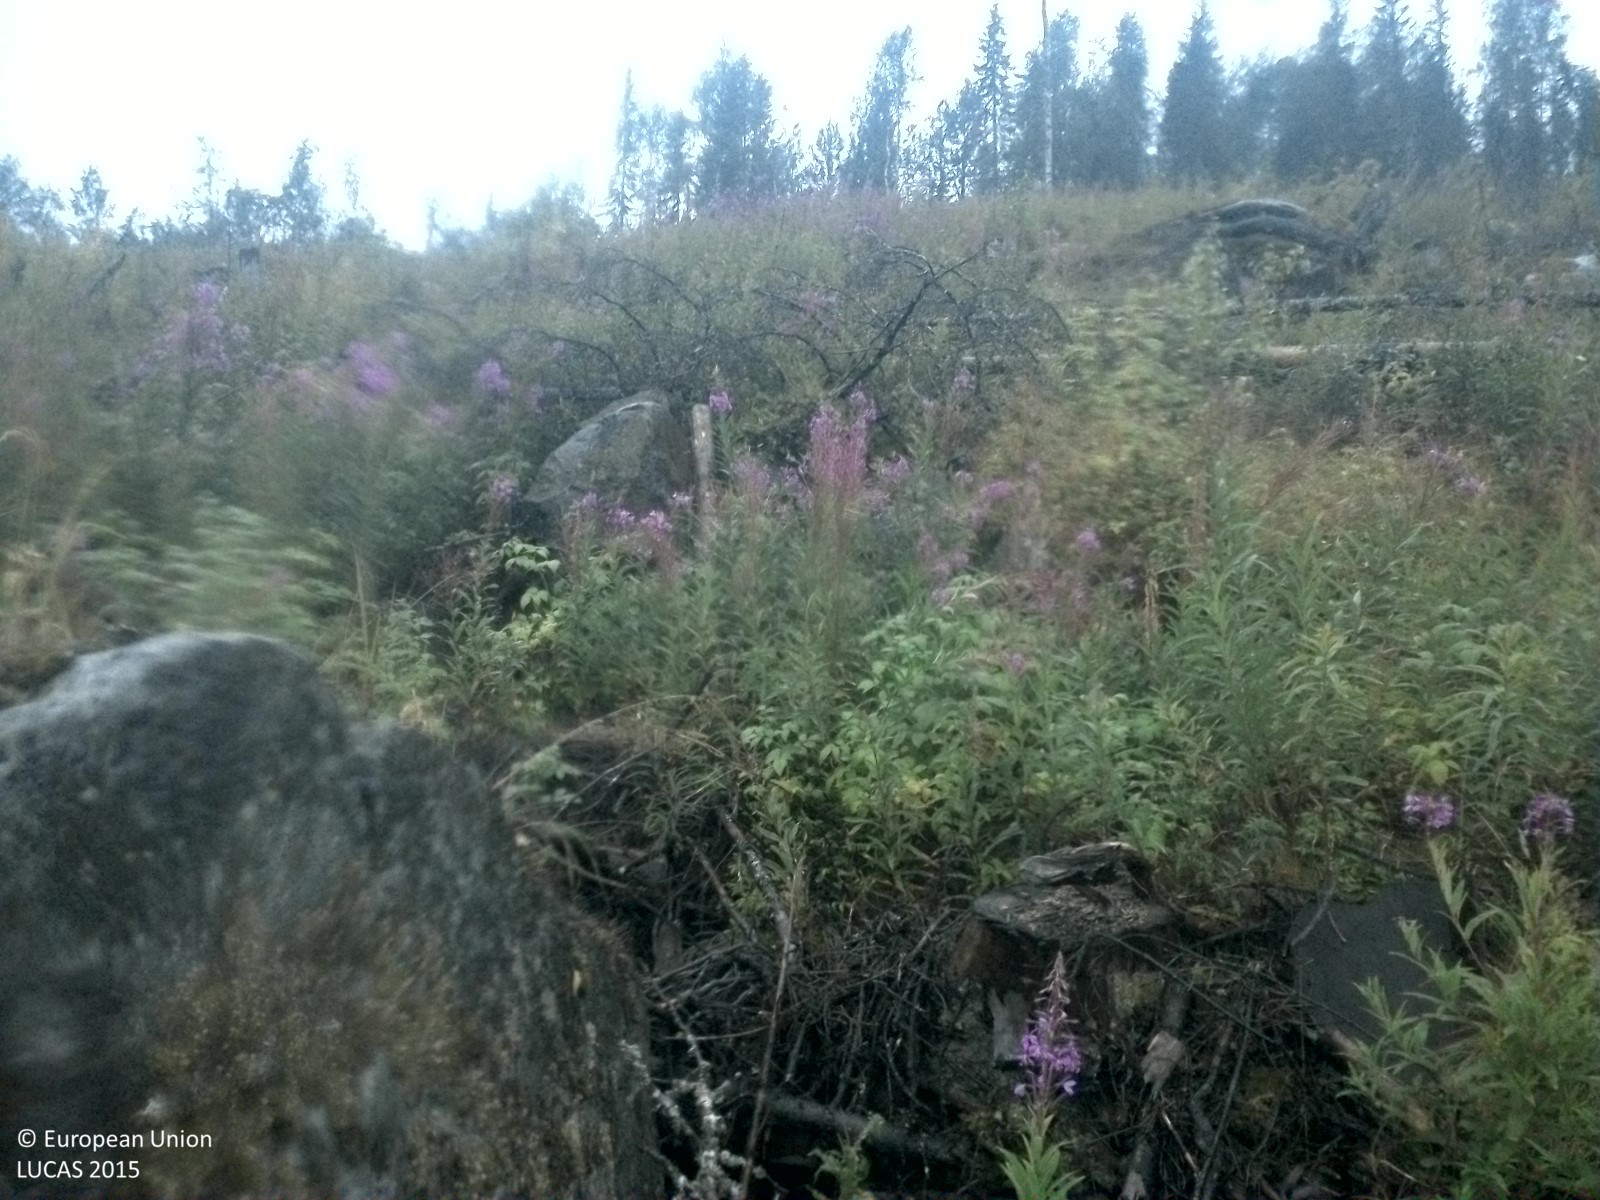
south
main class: Woodland
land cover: Spruce dominated mixed woodland
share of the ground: 10 - 25 %
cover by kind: herbaceous plants 35 %, shrubs 30 %, coniferous forest trees 15 %, consolidated bare surface 10 %, broadleaved forest trees 5 %, unconsolidated bare surface 5 %
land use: Forestry
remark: Clear cut
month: August
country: SE
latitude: 62.3719
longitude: 16.3007
